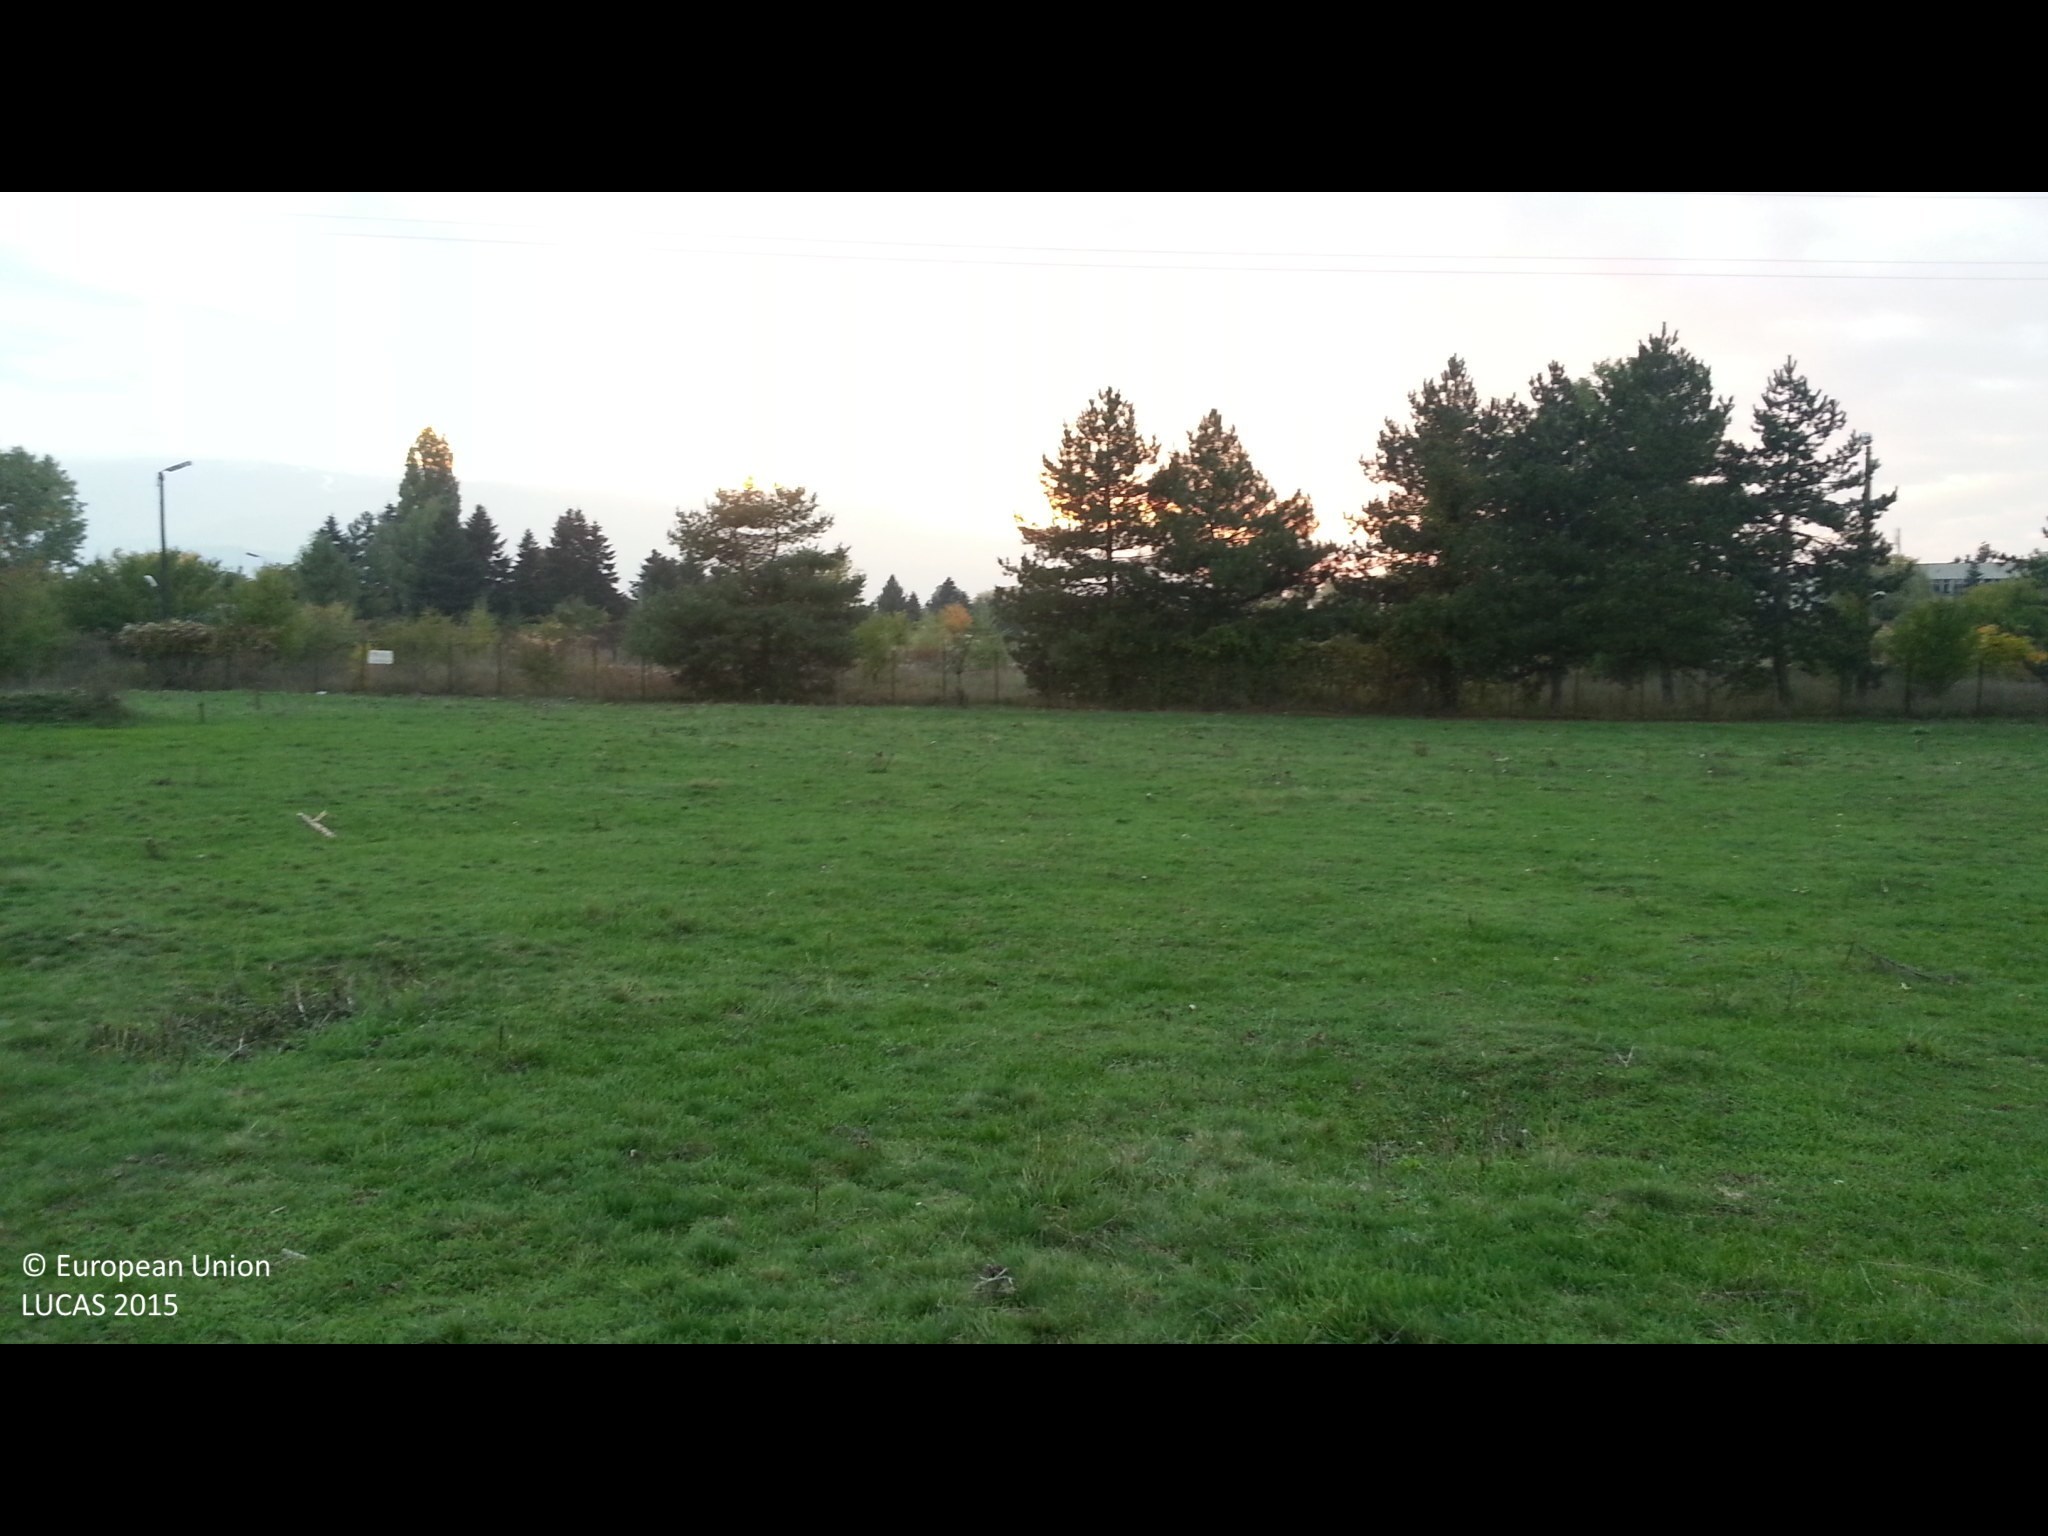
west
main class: Grassland
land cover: Grassland without tree/shrub cover
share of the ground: > 75 %
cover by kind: herbaceous plants 100 %
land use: Agriculture (excluding fallow land and kitchen gardens)
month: October
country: BG
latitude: 42.6316
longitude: 23.4367
